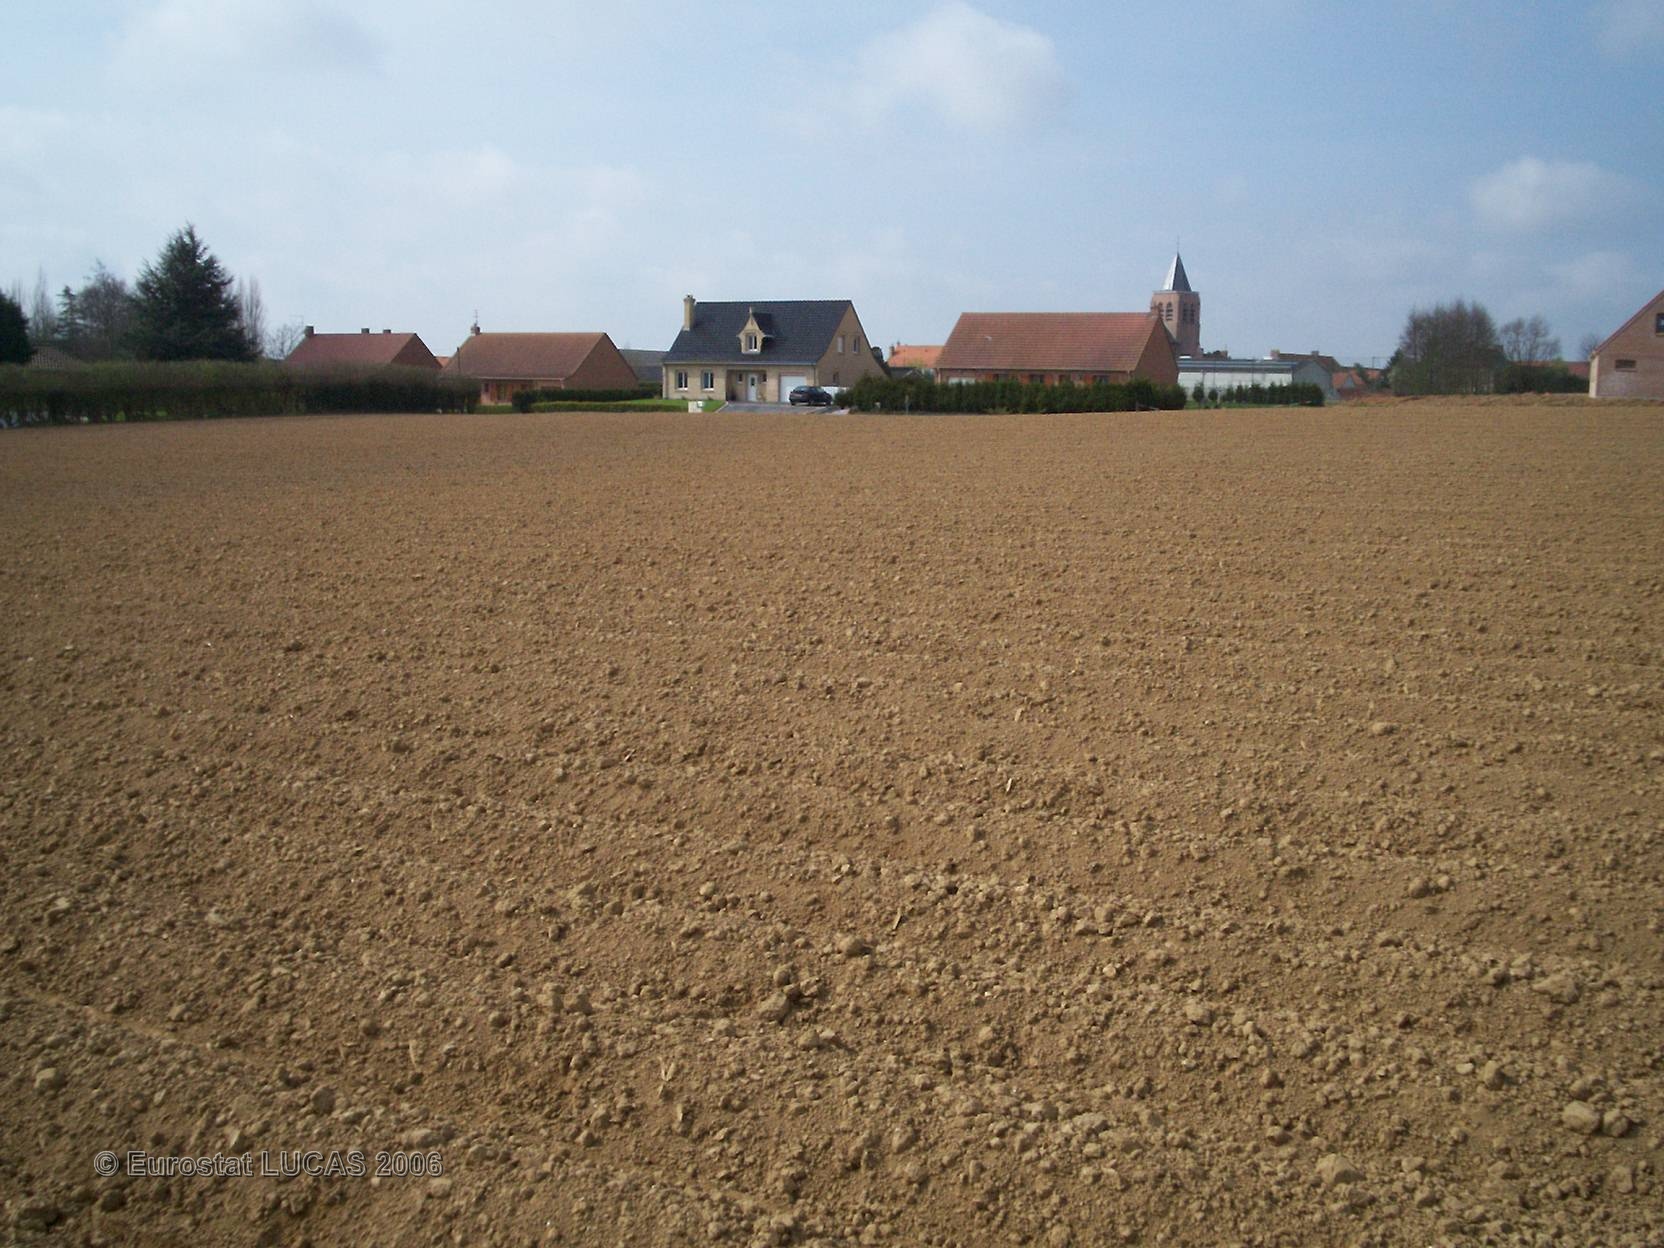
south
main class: Cropland
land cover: Potatoes
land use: Agriculture (excluding fallow land and kitchen gardens)
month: April
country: FR
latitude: 50.7866
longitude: 2.5120
